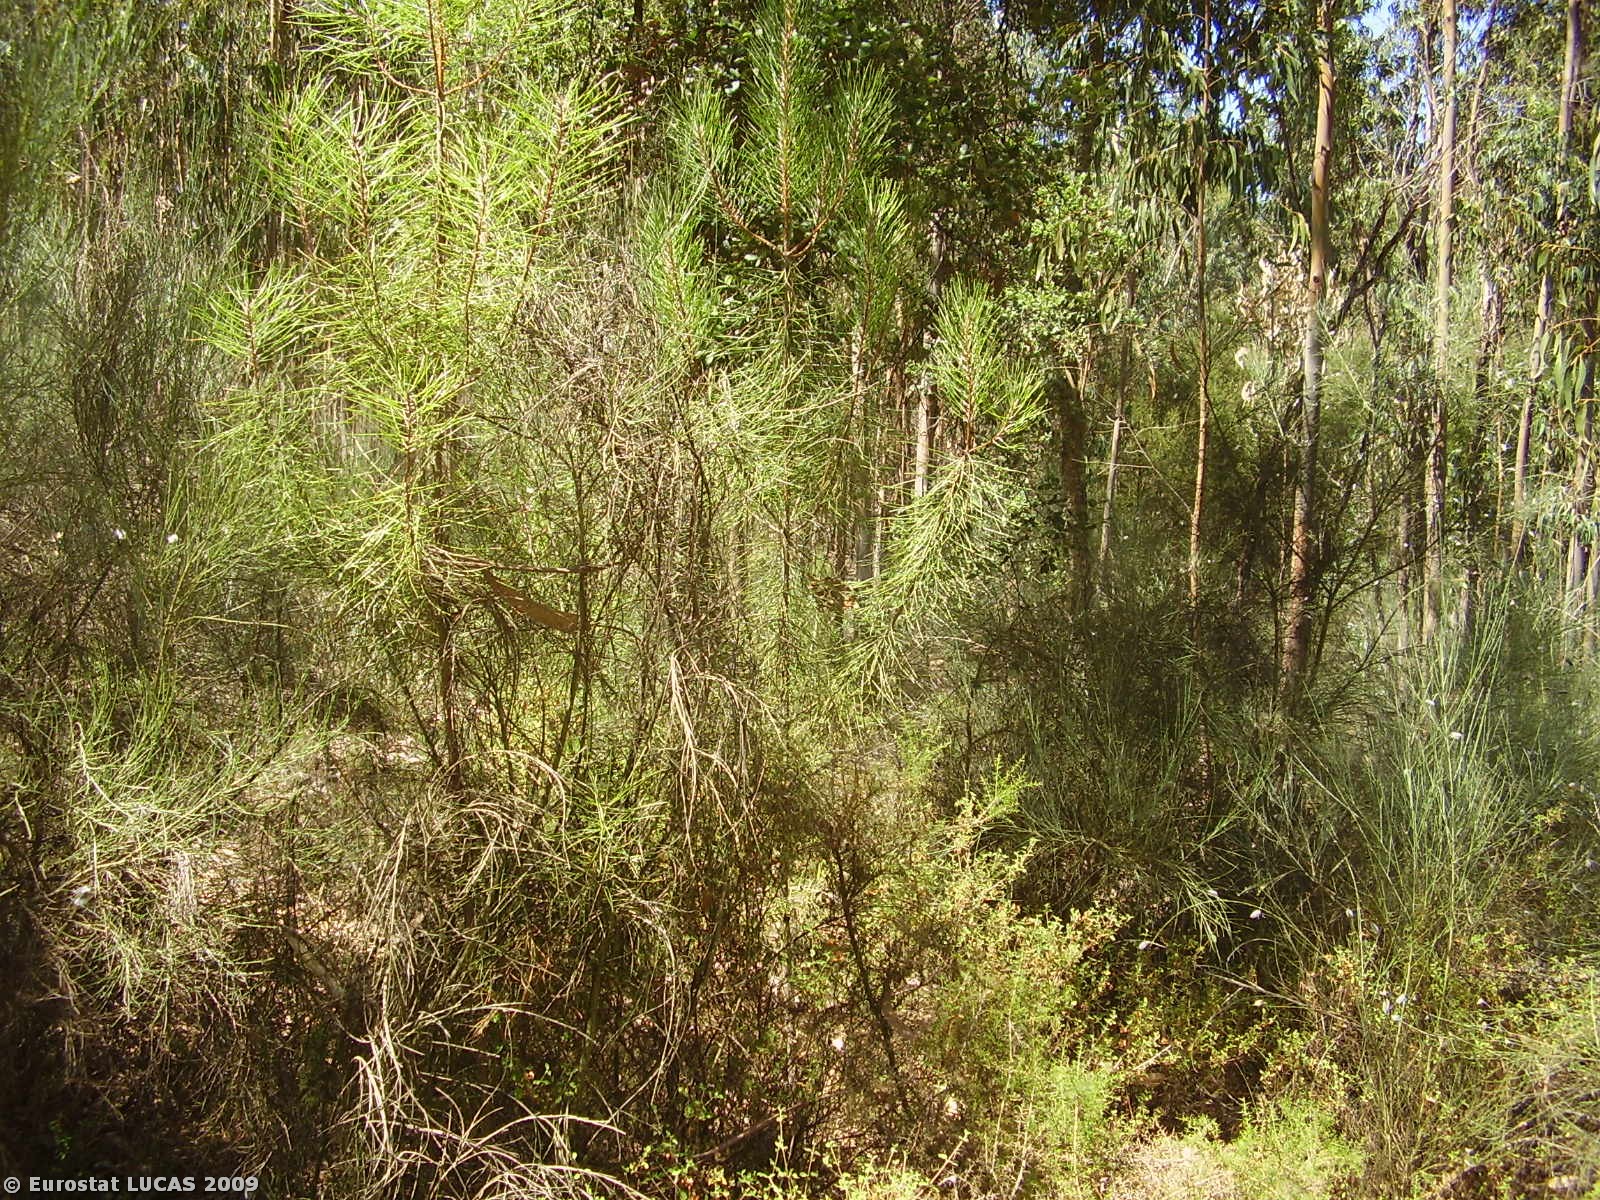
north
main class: Woodland
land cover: Mixed woodland
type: plantations and self-sown exotic forest
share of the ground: 25 - 50 %
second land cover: Spontaneously vegetated surfaces
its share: 50 - 75 %
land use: Forestry
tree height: > 5 m
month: July
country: PT
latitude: 39.3521
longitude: -7.9611
